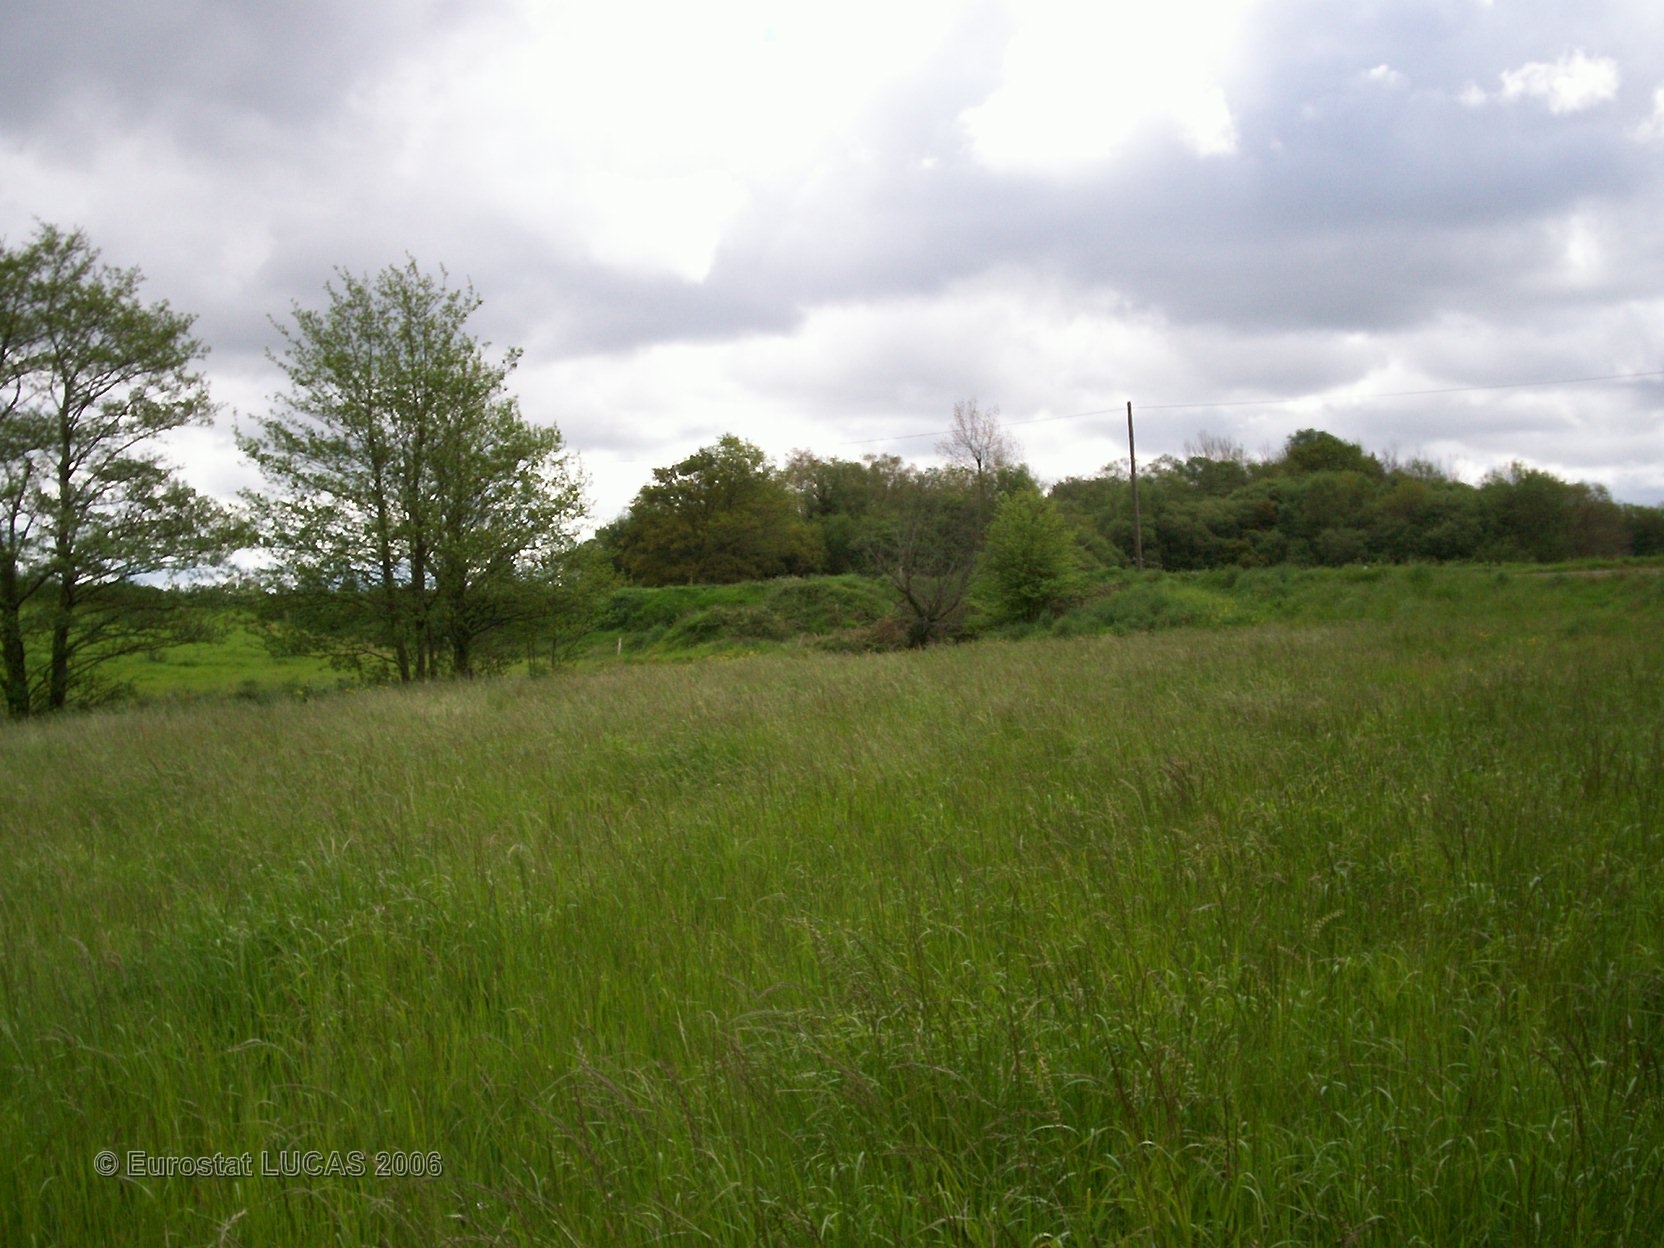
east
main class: Grassland
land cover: Grassland without tree/shrub cover
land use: Agriculture (excluding fallow land and kitchen gardens)
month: May
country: FR
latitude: 48.5816
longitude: -3.7341
